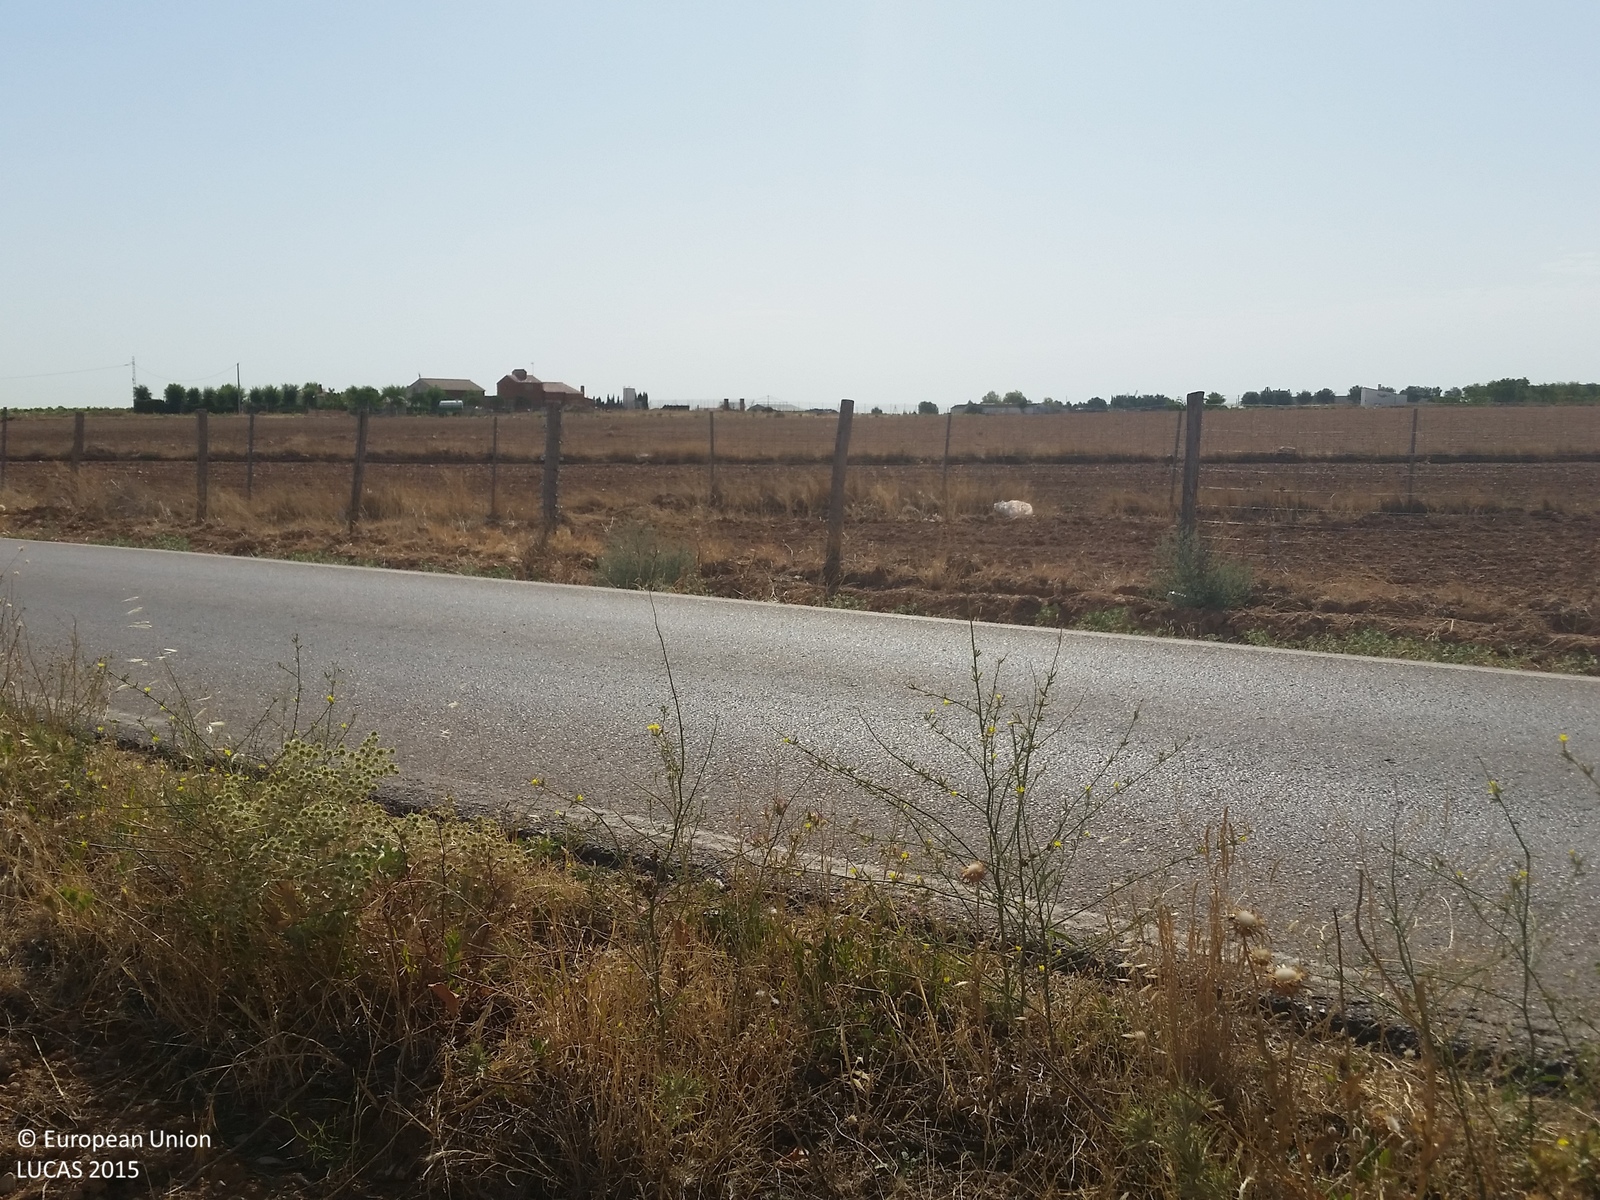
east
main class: Cropland
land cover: Vineyards
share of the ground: 50 - 75 %
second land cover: Other bare soil
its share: > 75 %
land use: Agriculture (excluding fallow land and kitchen gardens)
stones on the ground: 10 - 25 %
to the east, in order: Vineyards; Other bare soil; Grass margins; Paved roads, cycling and walking lanes; Grass margins; Fences; Other bare soil; Fences; Grass margins; Other bare soil; Grass margins; Nuts trees
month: July
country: ES
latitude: 39.2882
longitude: -2.5896
